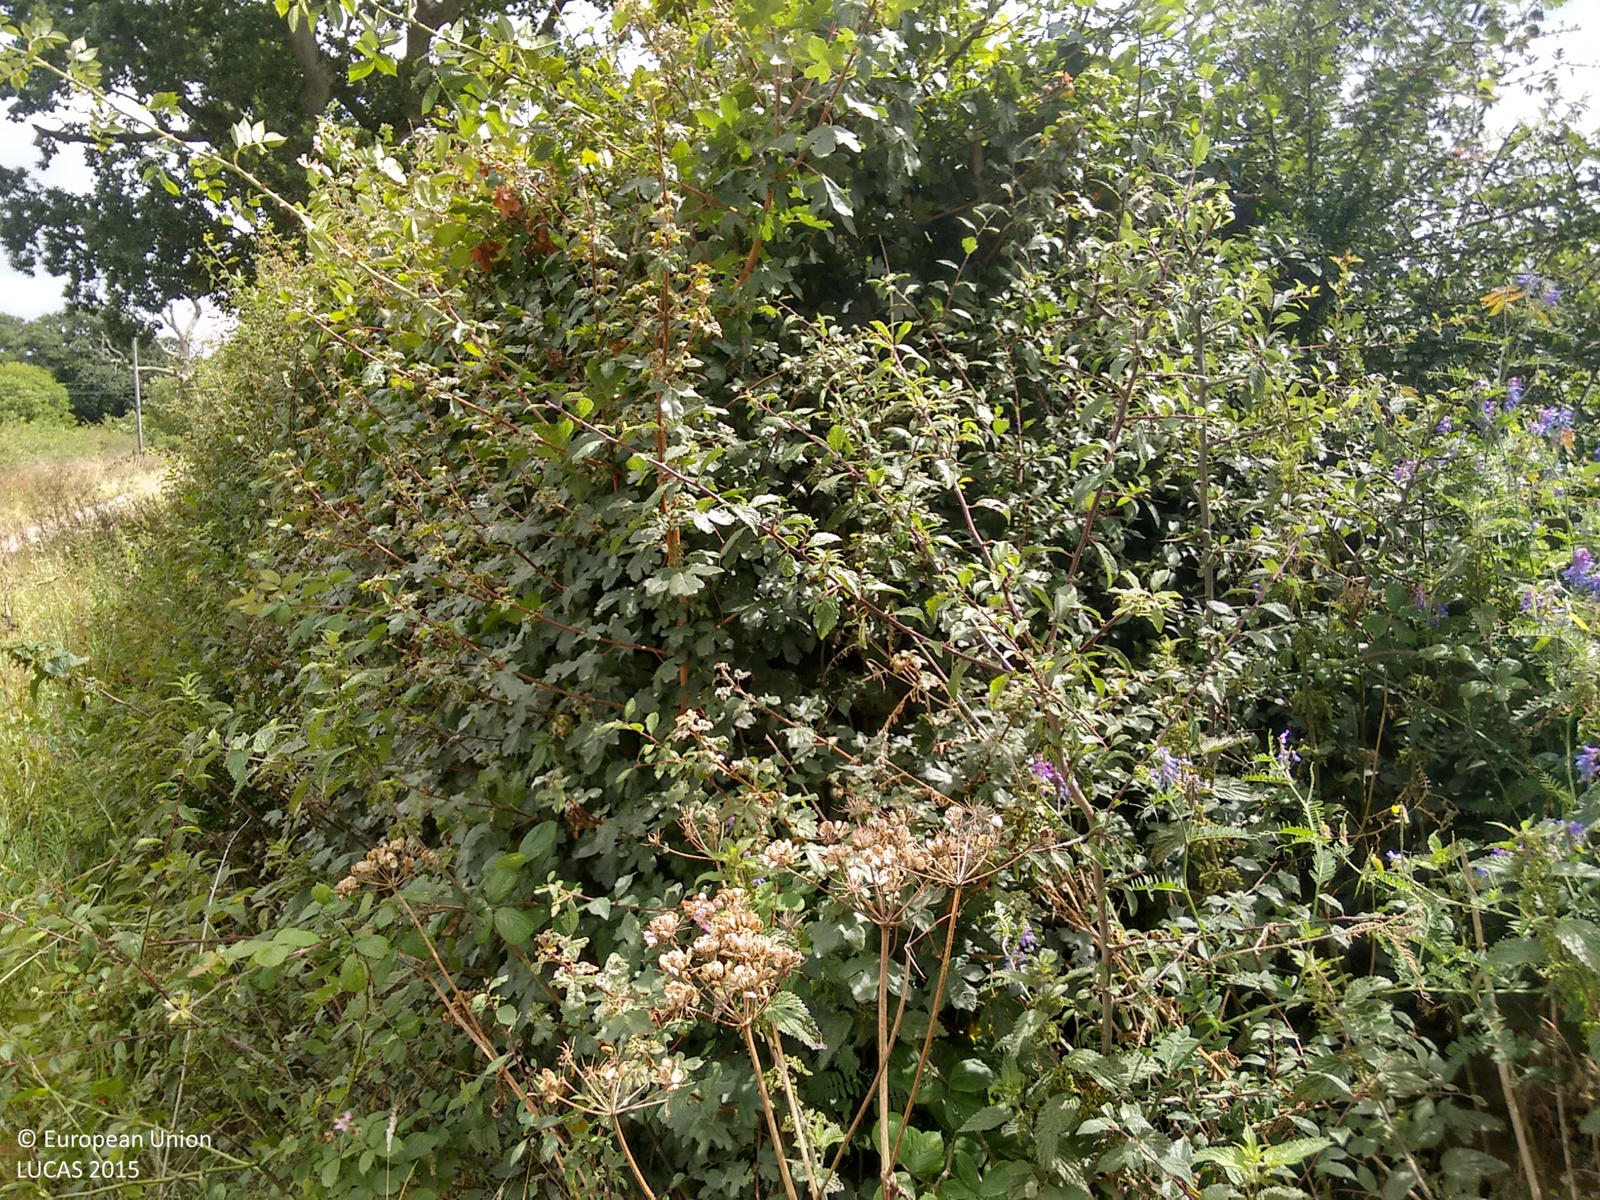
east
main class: Grassland
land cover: Grassland without tree/shrub cover
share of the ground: > 75 %
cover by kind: herbaceous plants 100 %
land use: Agriculture (excluding fallow land and kitchen gardens)
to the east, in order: Grassland without tree/shrub cover; Fences; Grassland without tree/shrub cover; Fences; Grassland without tree/shrub cover; Fences; Broadleaved woodland; Rivers and streams; Broadleaved woodland; Artificial constructions in urban areas
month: July
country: GB
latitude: 50.6656
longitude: -3.3951
